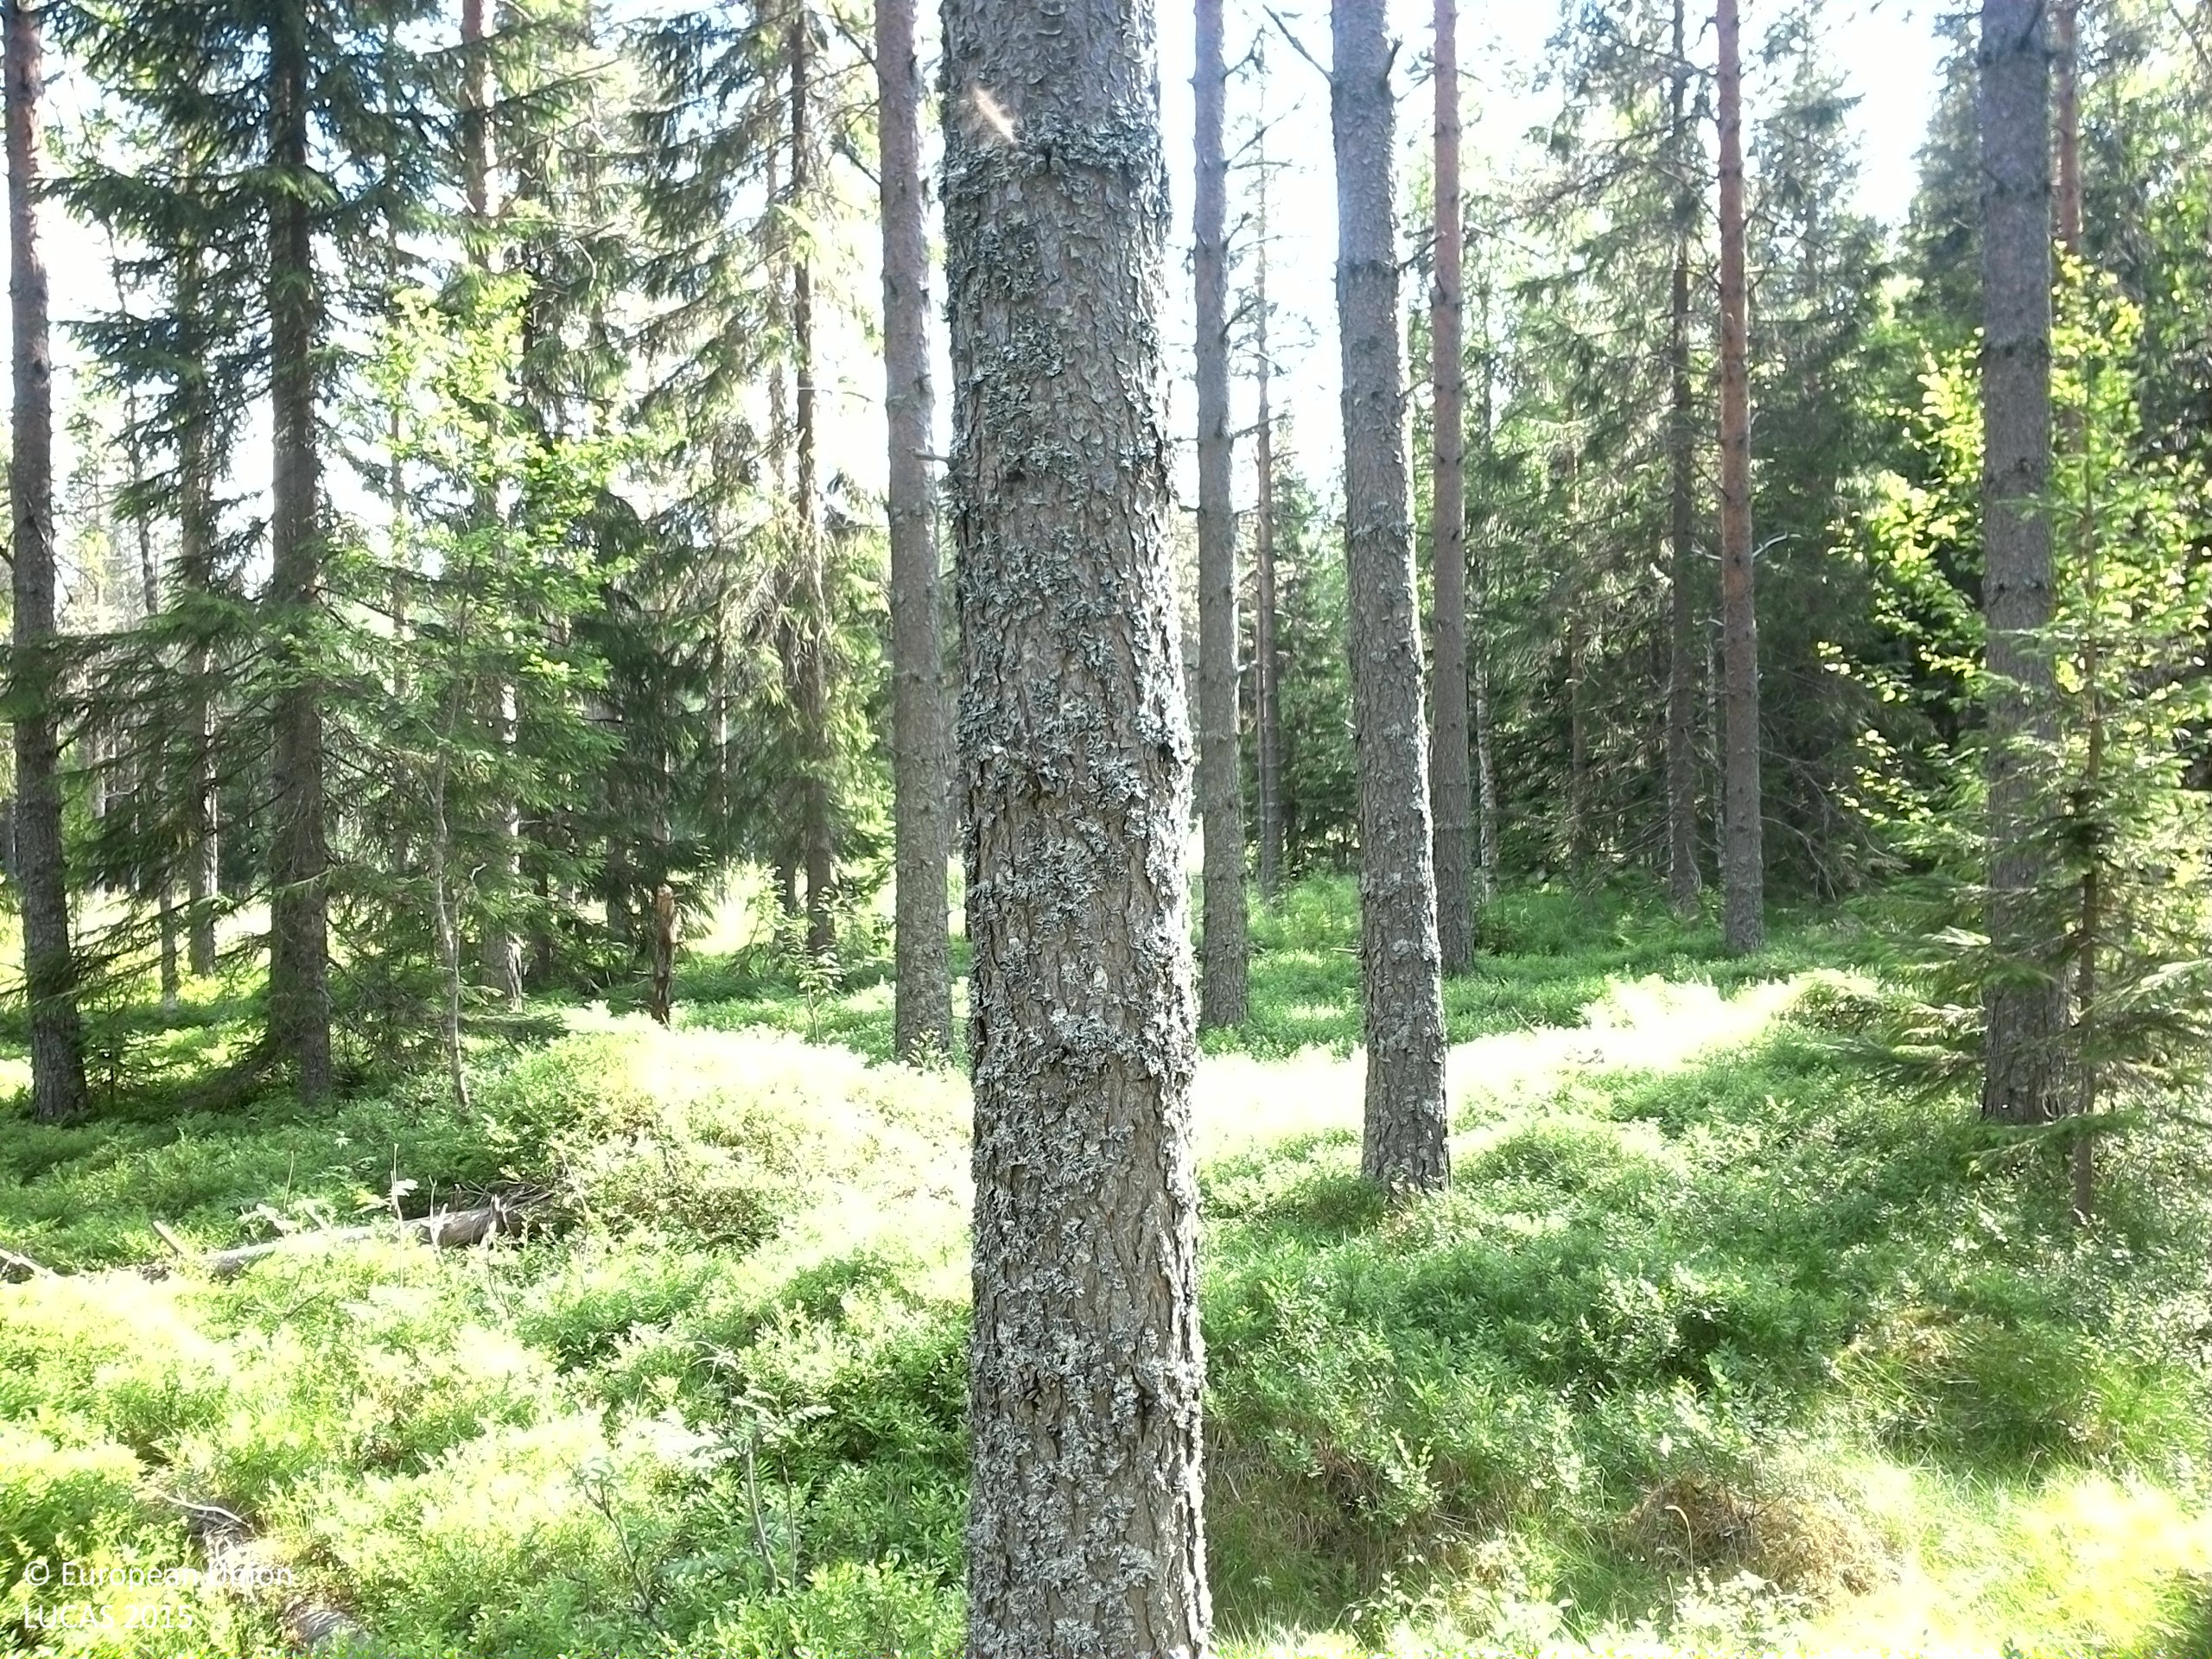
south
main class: Woodland
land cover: Pine dominated coniferous woodland
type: boreal forest
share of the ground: 50 - 75 %
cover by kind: coniferous forest trees 60 %, shrubs 35 %, broadleaved forest trees 5 %
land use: Forestry
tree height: > 5 m
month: July
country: SE
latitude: 63.5306
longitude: 17.5148
